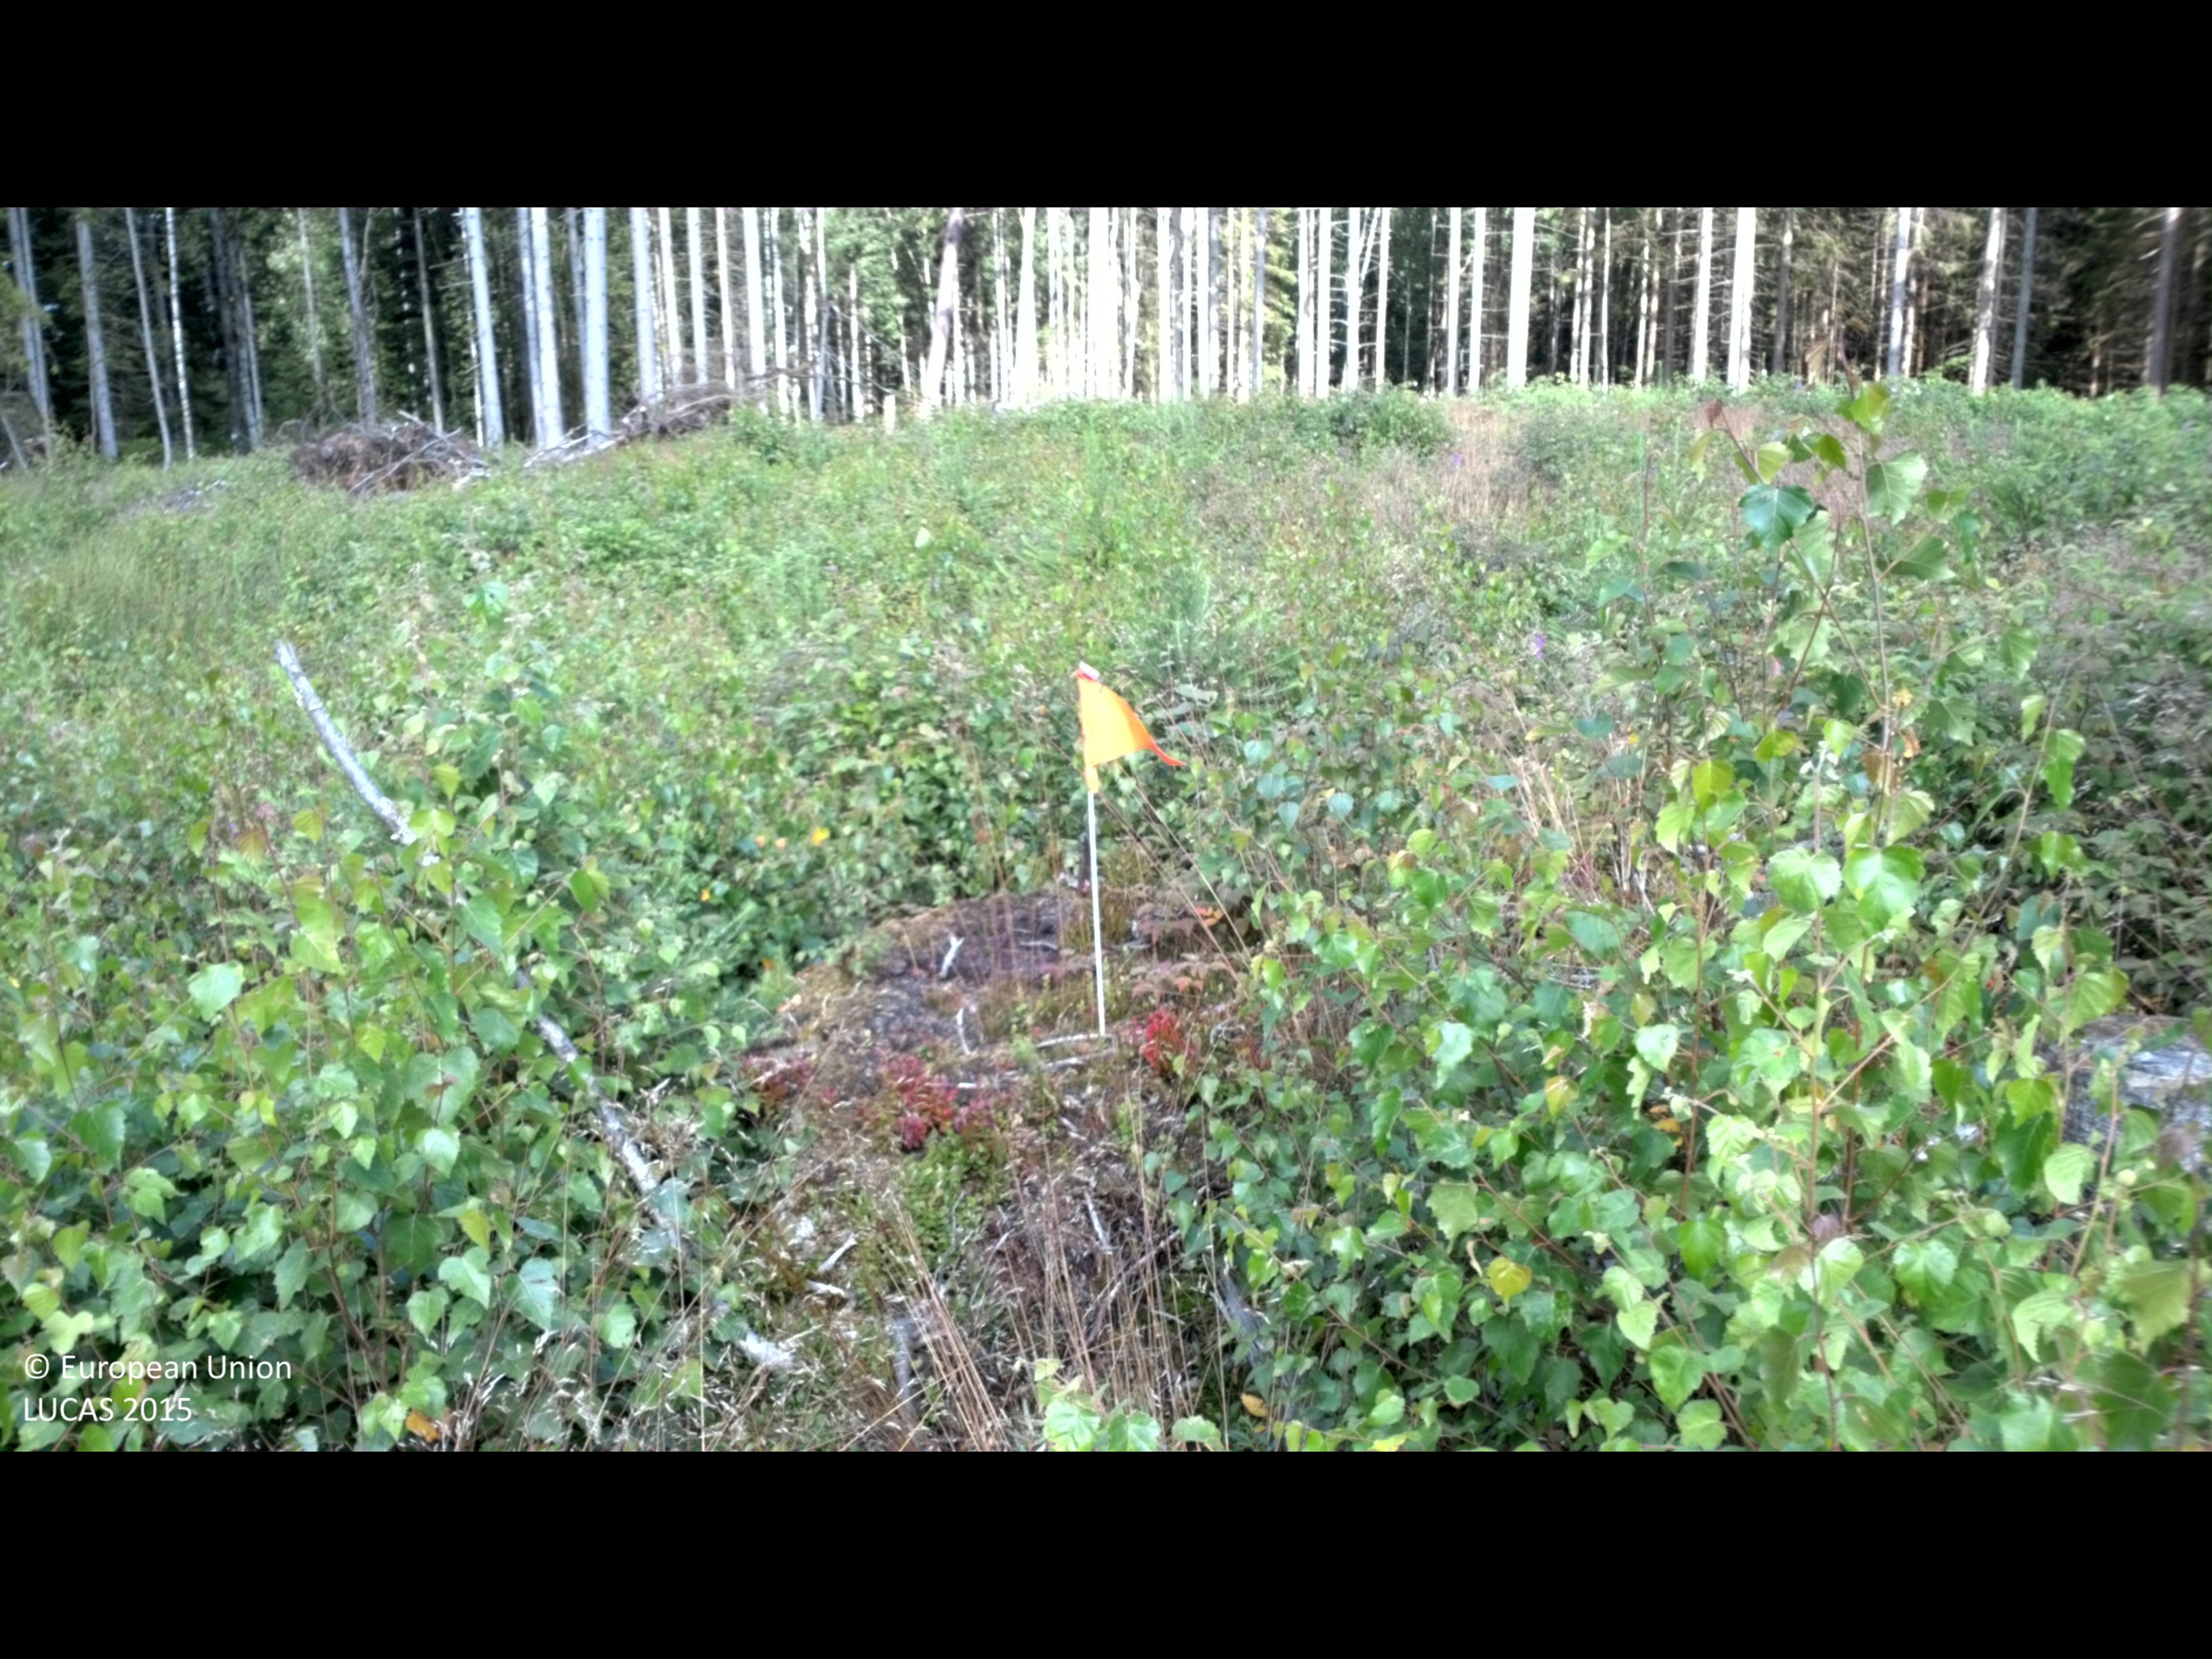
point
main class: Woodland
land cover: Broadleaved woodland
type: boreal forest
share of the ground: > 75 %
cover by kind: broadleaved forest trees 75 %, shrubs 15 %, coniferous forest trees 10 %
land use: Forestry
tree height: < 5 m
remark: Clear cut
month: August
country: SE
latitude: 56.3762
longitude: 14.5803
